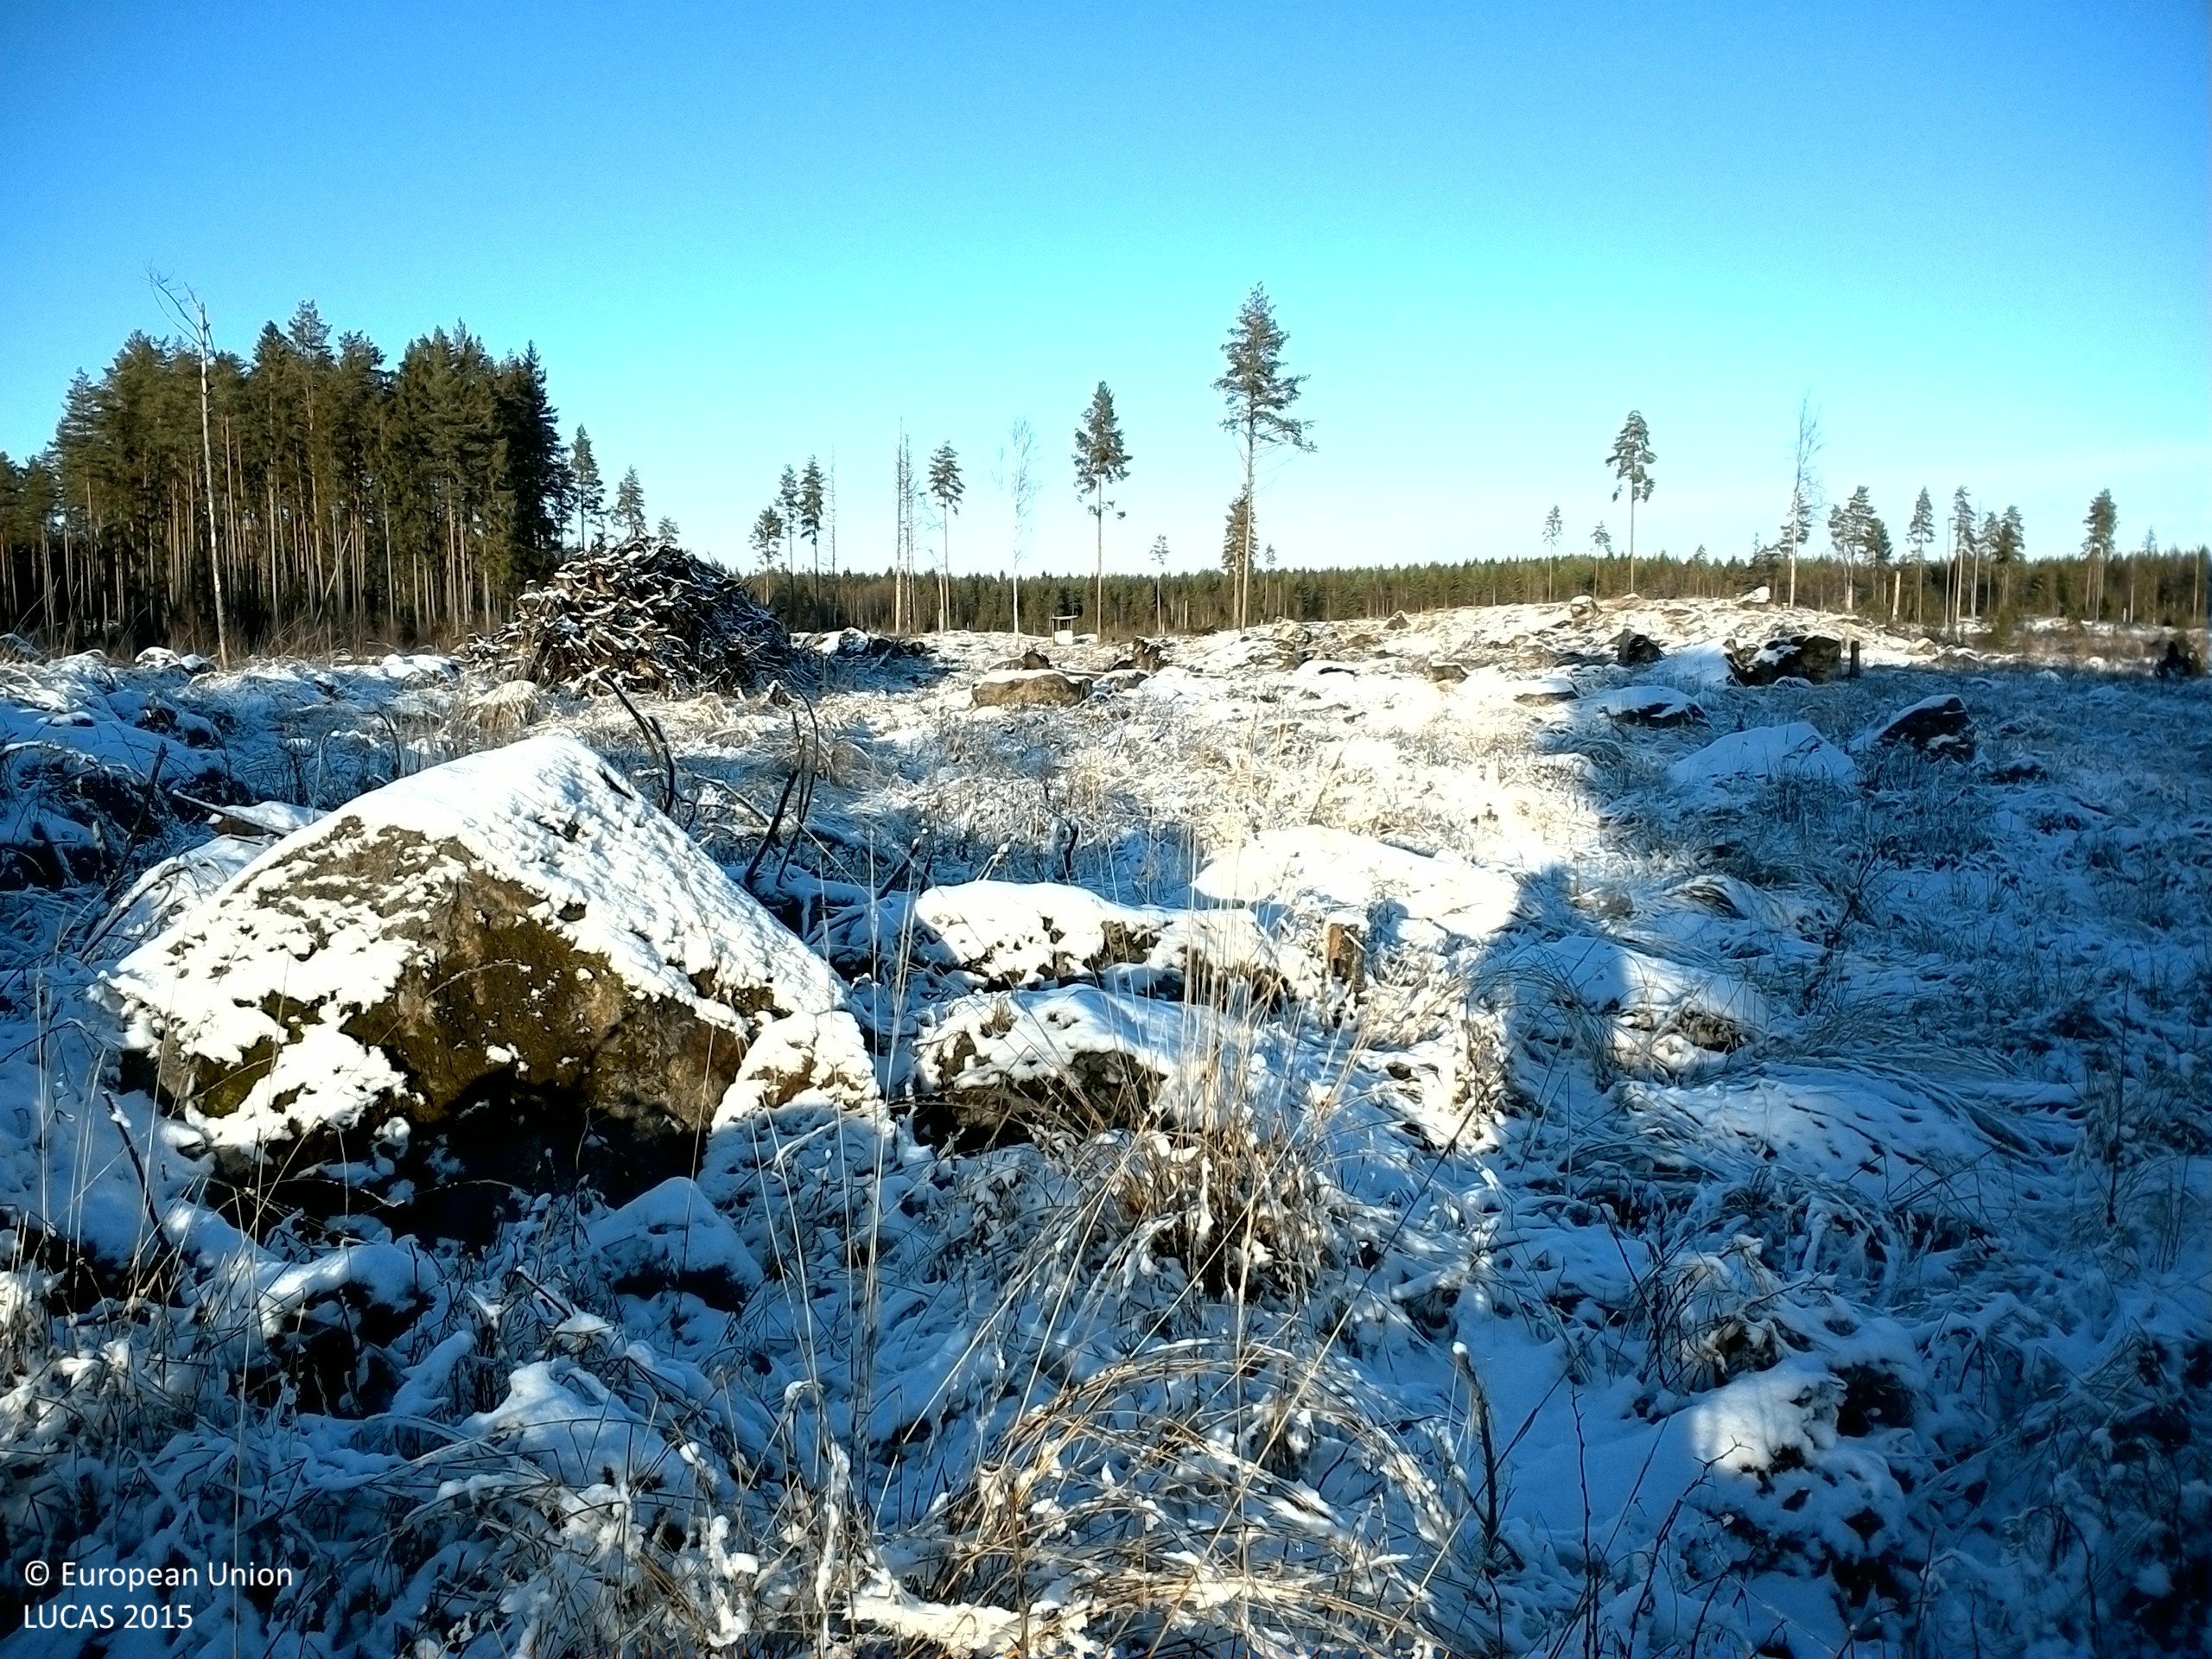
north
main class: Grassland
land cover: Grassland with sparse tree/shrub cover
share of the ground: > 75 %
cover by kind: herbaceous plants 70 %, consolidated bare surface 25 %, broadleaved forest trees 5 %
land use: Forestry
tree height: > 5 m
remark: Clear cut
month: November
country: SE
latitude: 59.6936
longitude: 16.3696
